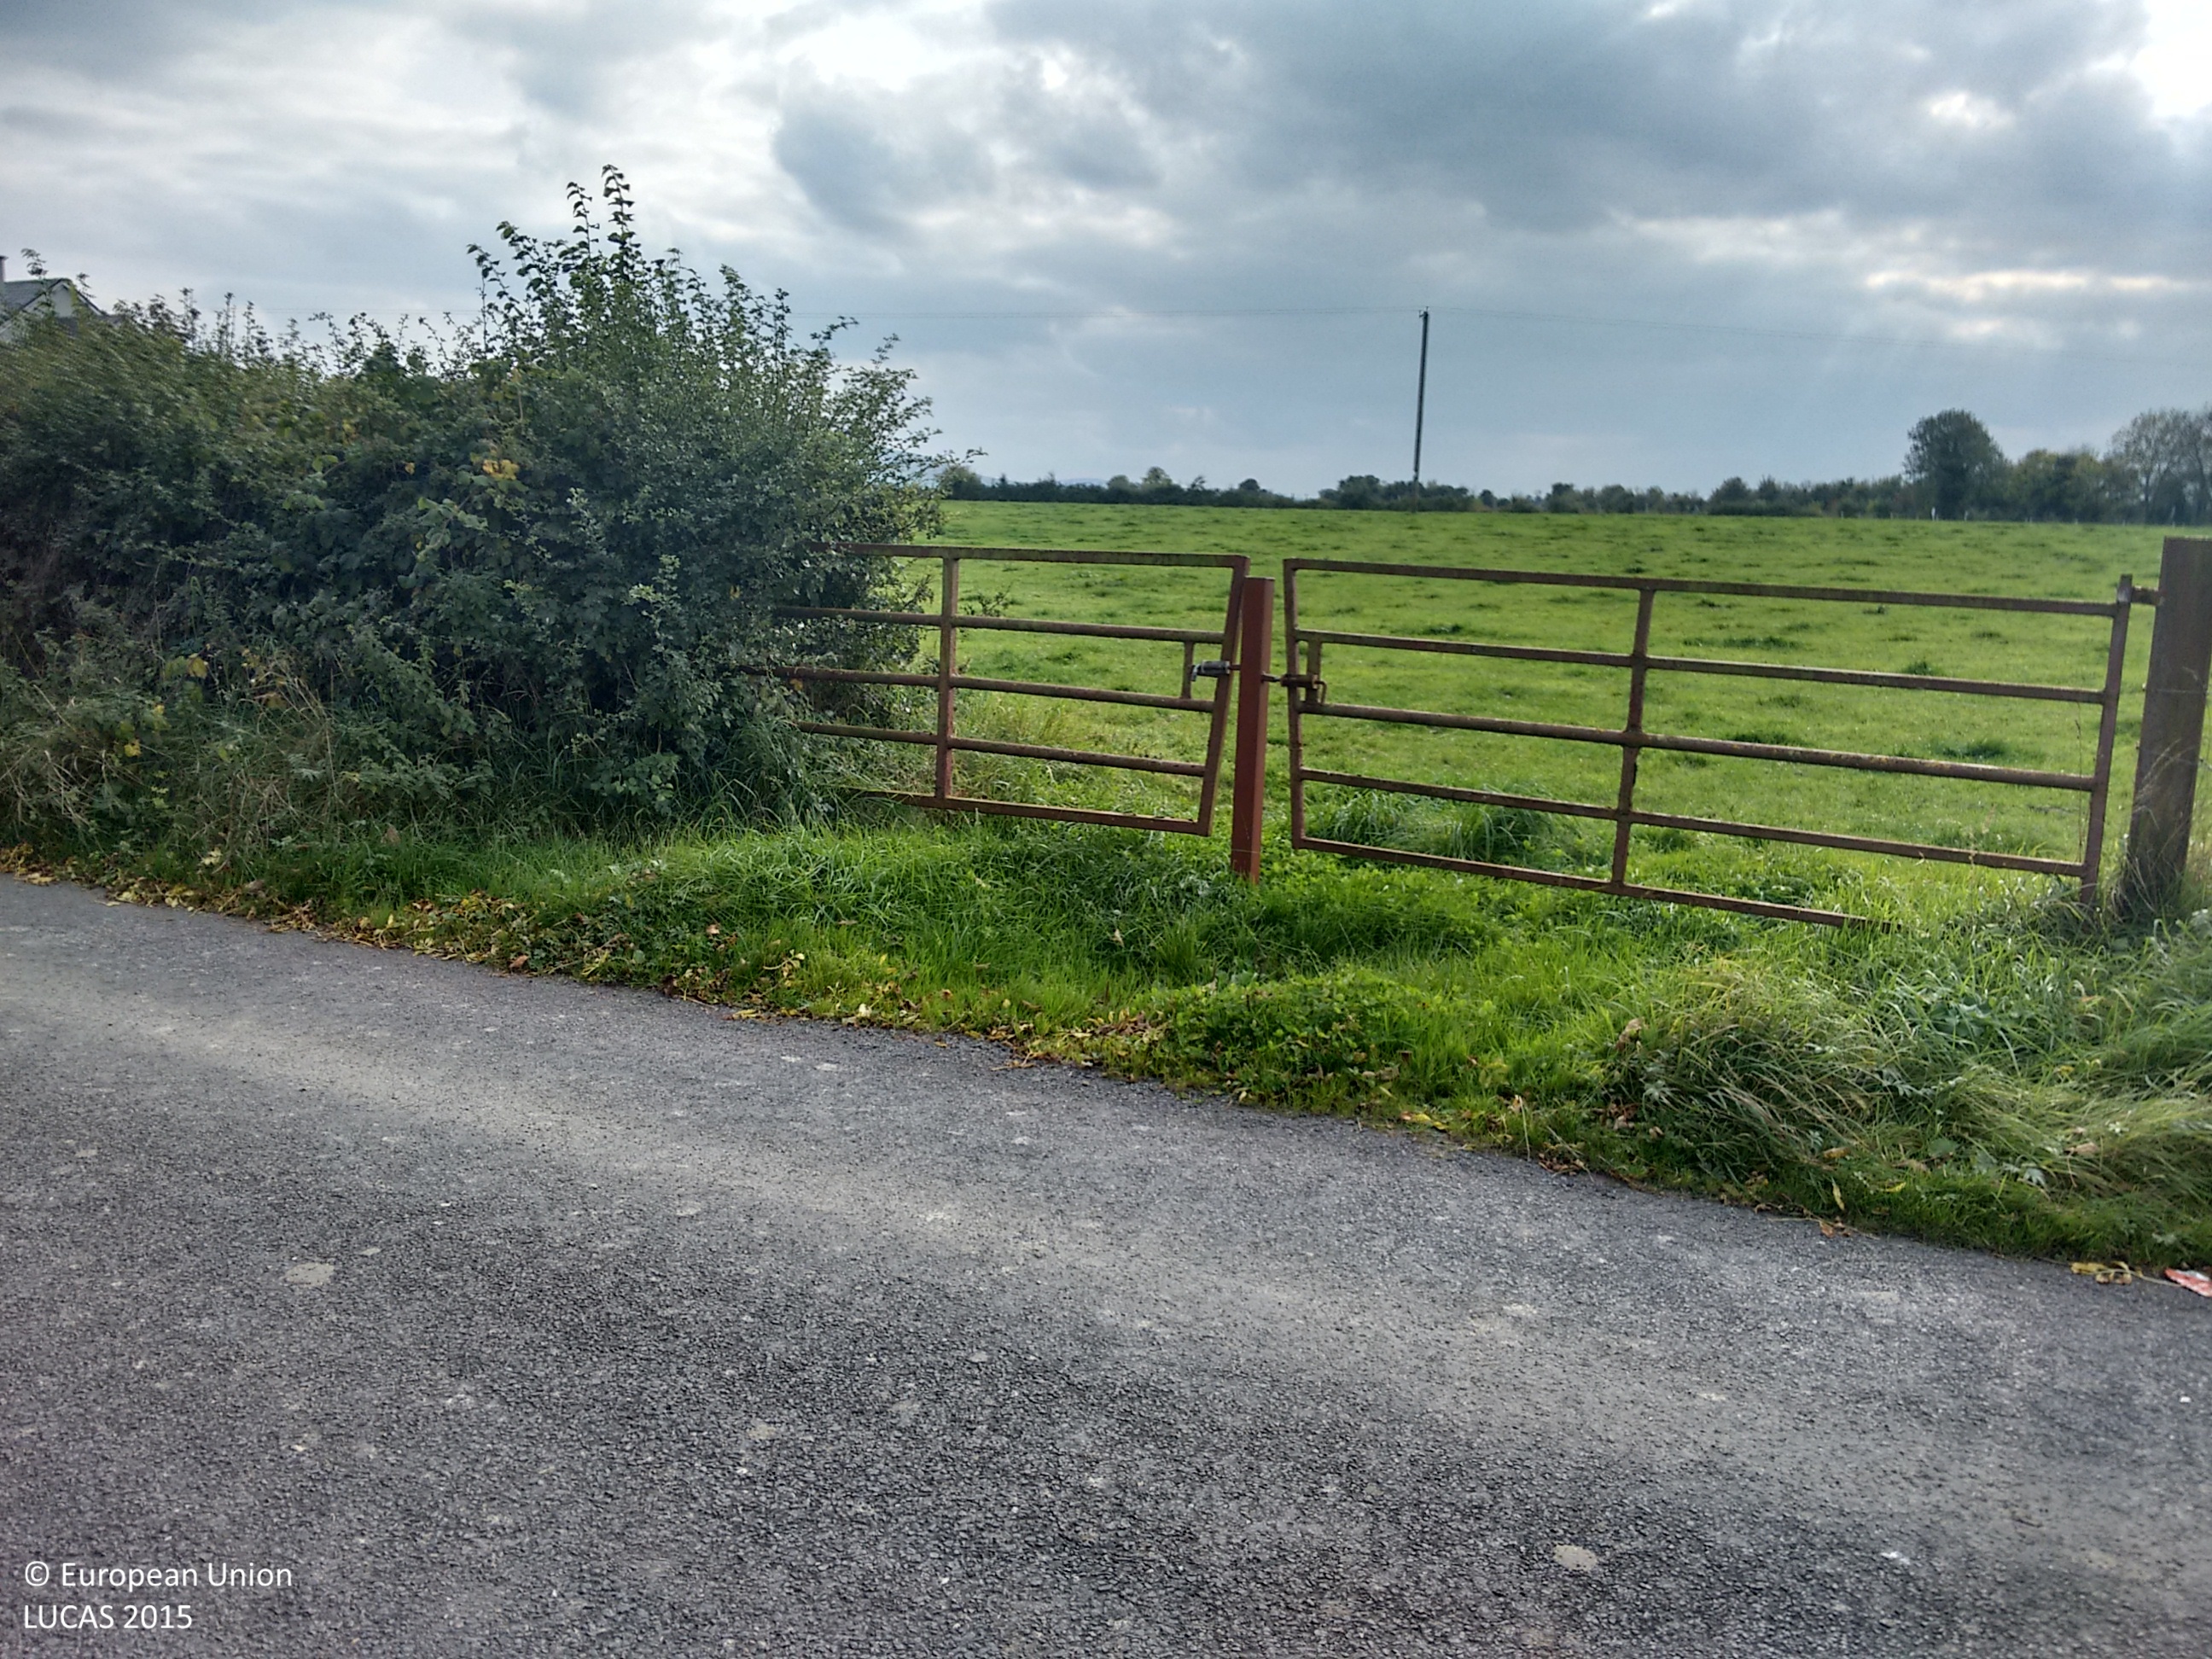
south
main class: Grassland
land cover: Grassland without tree/shrub cover
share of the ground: > 75 %
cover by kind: herbaceous plants 100 %
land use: Agriculture (excluding fallow land and kitchen gardens)
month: October
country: IE
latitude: 52.9511
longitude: -7.9296
